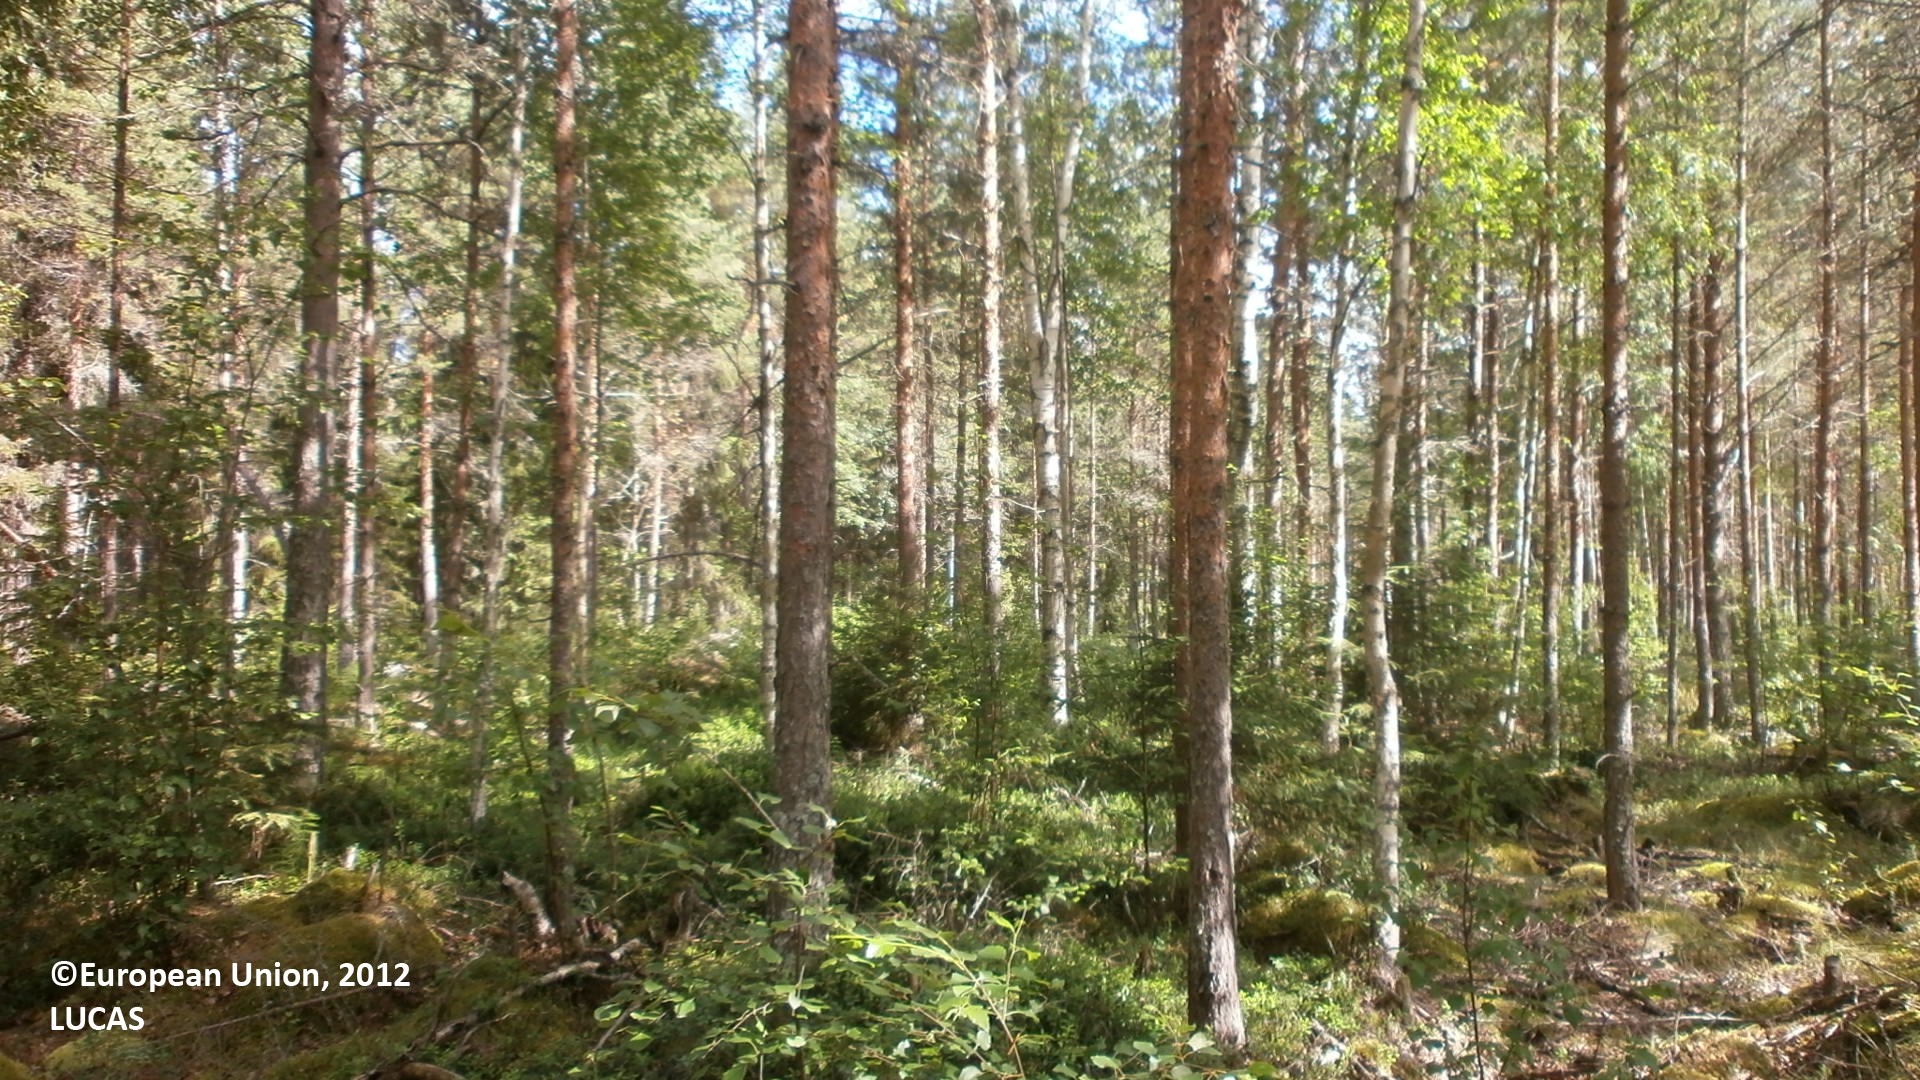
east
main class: Woodland
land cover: Pine dominated mixed woodland
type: boreal forest
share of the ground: 50 - 75 %
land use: Forestry
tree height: > 5 m
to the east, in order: Pine dominated mixed woodland; Ditches and canals; Pine dominated coniferous woodland; Spruce dominated coniferous woodland; Ditches and canals; Spruce dominated coniferous woodland; Ditches and canals; Pine dominated coniferous woodland
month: July
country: FI
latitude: 64.0063
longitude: 23.8671
